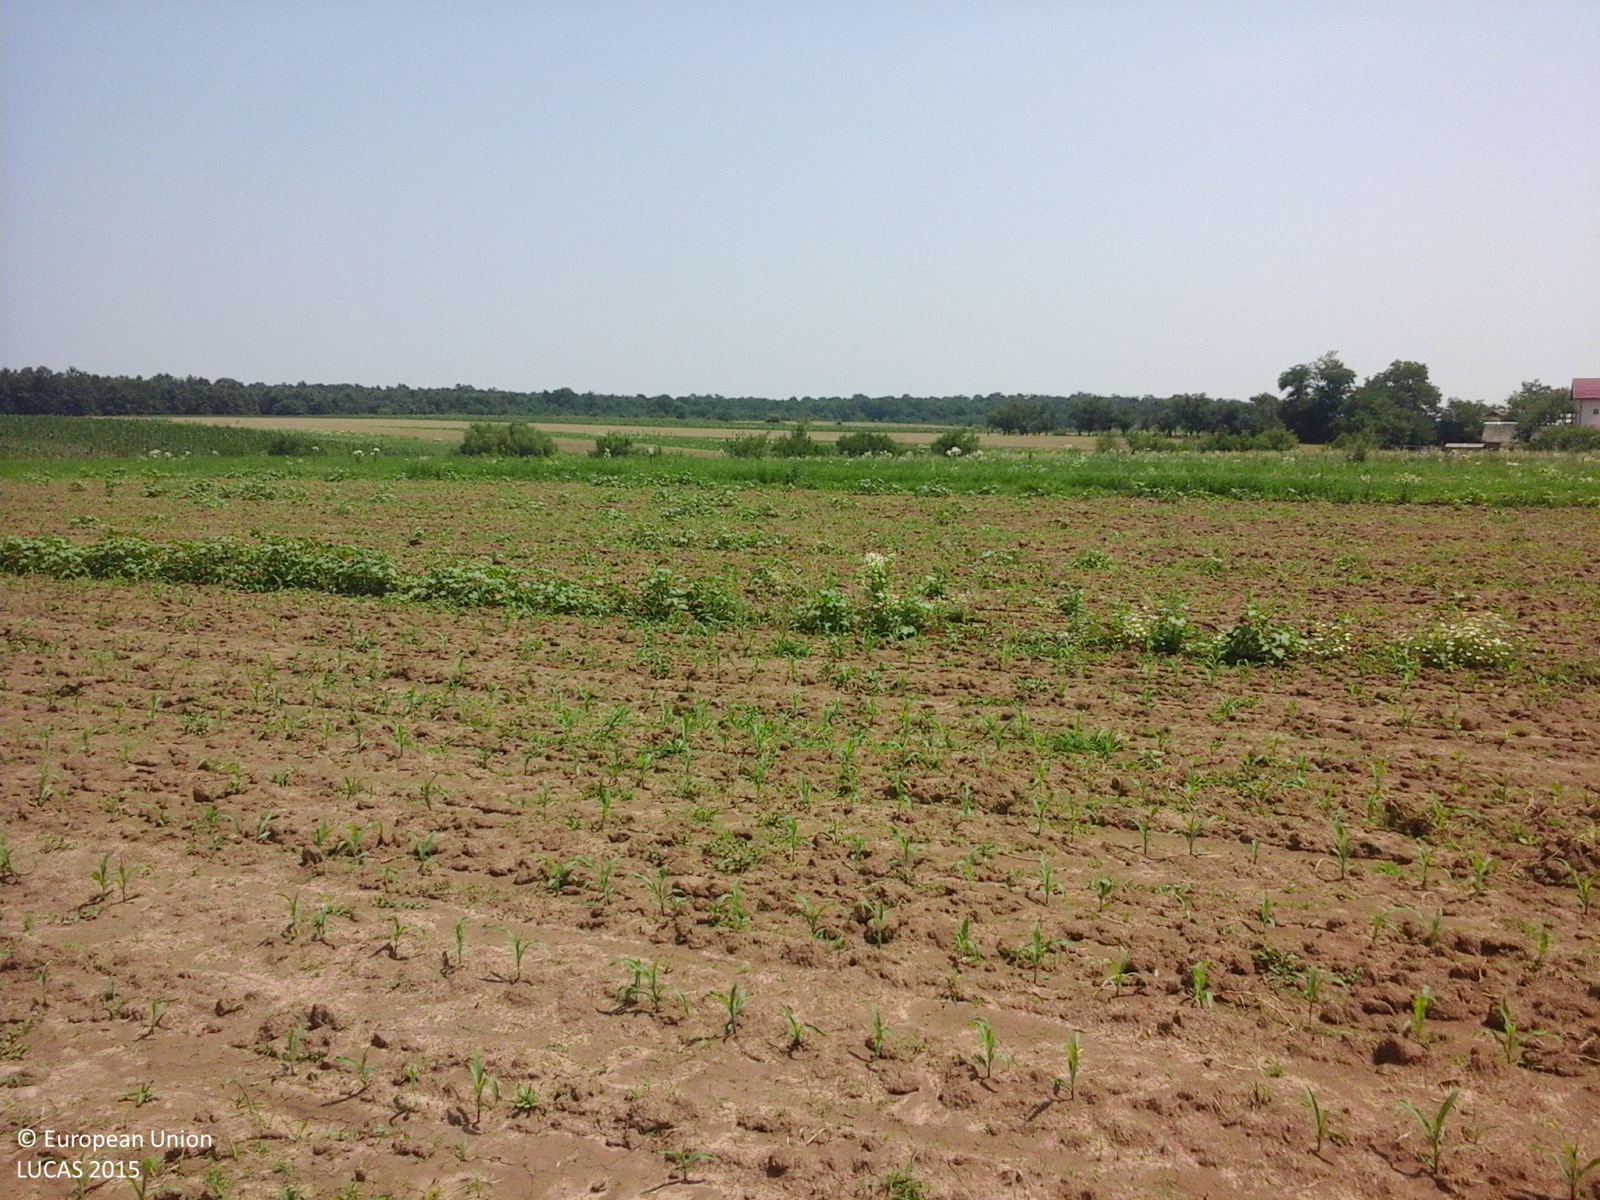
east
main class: Cropland
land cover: Maize
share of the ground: < 10 %
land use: Agriculture (excluding fallow land and kitchen gardens)
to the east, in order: Maize; Grass margins; Maize; Grass margins; Lucerne; Maize; Grass margins; Lucerne; Grass margins; Maize; Grass margins; Other leguminous and mixtures for fodder; Grass margins; Maize; Oats; Grass margins; Lucerne; Grassland without tree/shrub cover; Tracks; Grass margins; Lines of trees; Inland fresh running water; Grass margins; Spontaneously vegetated surfaces; Common wheat; Other fresh vegetables; Maize; Common wheat; Other fruit trees and berries; Common wheat
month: July
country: RO
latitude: 44.5518
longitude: 25.3843
